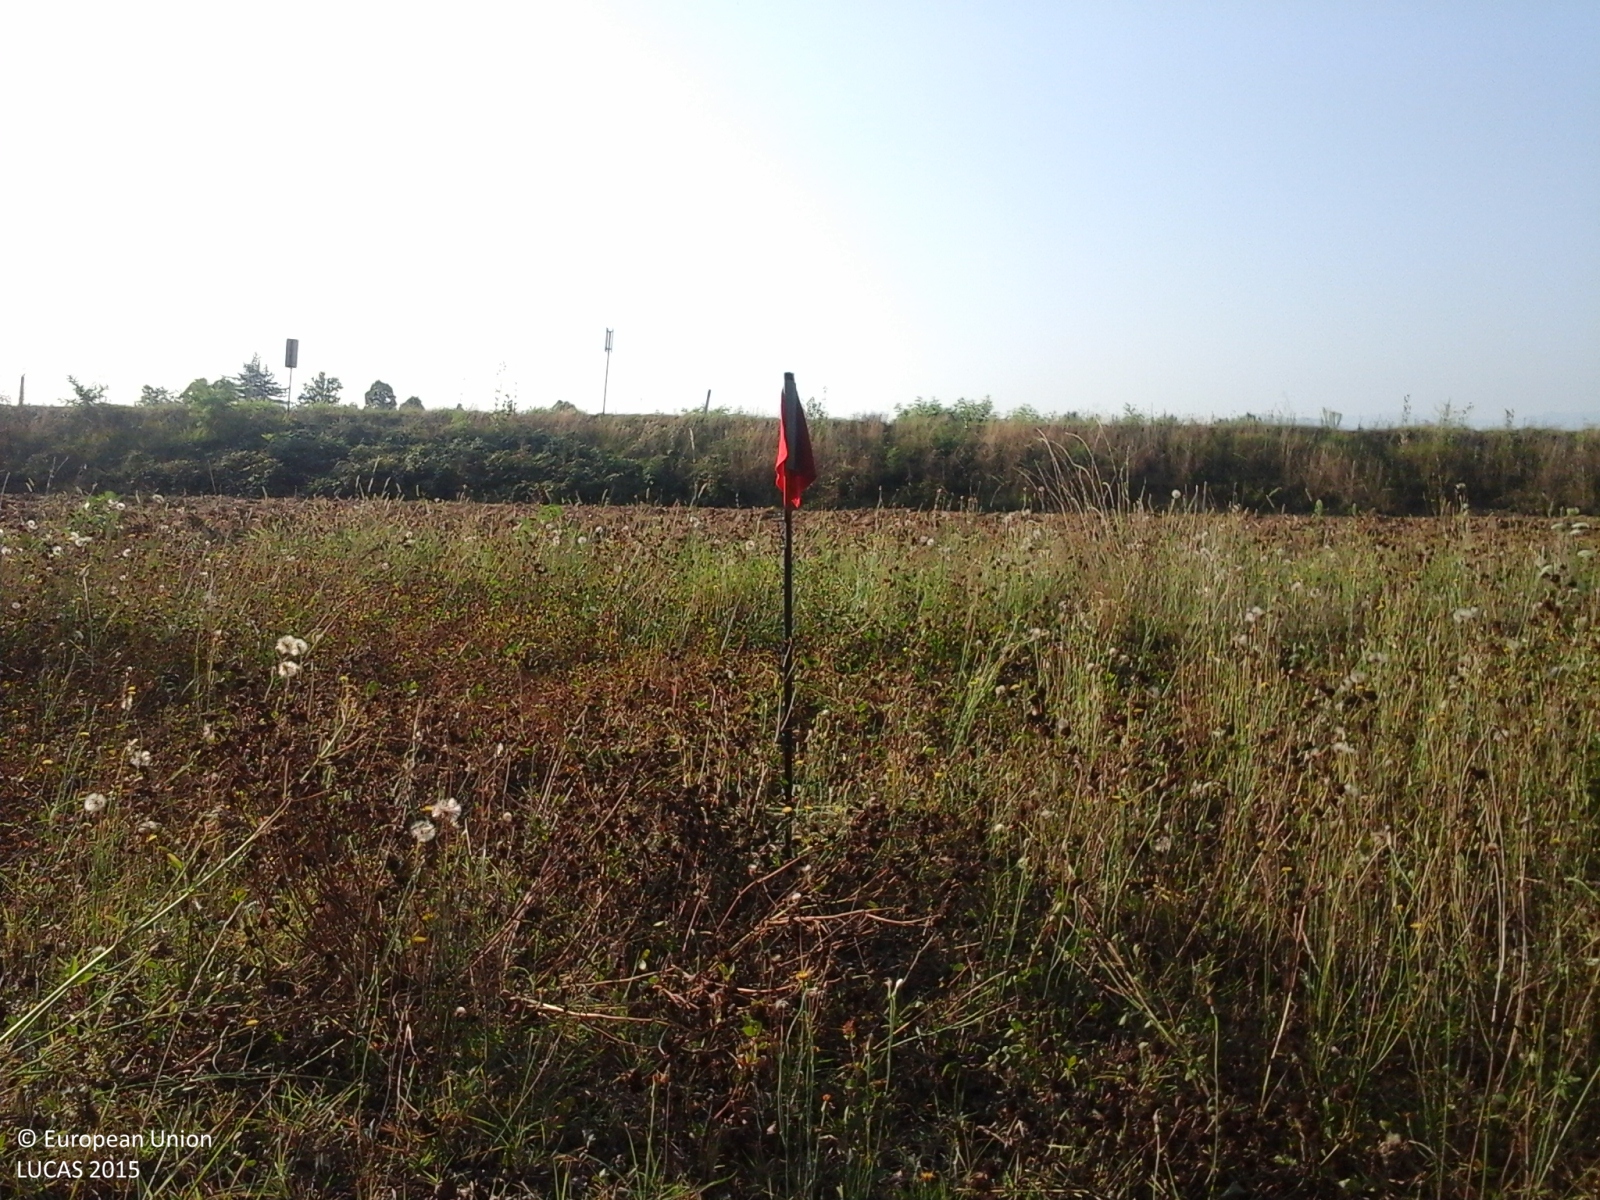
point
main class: Grassland
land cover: Grassland without tree/shrub cover
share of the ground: > 75 %
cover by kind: herbaceous plants 100 %
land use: Agriculture (excluding fallow land and kitchen gardens)
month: August
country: IT
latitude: 44.4176
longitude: 7.8068
